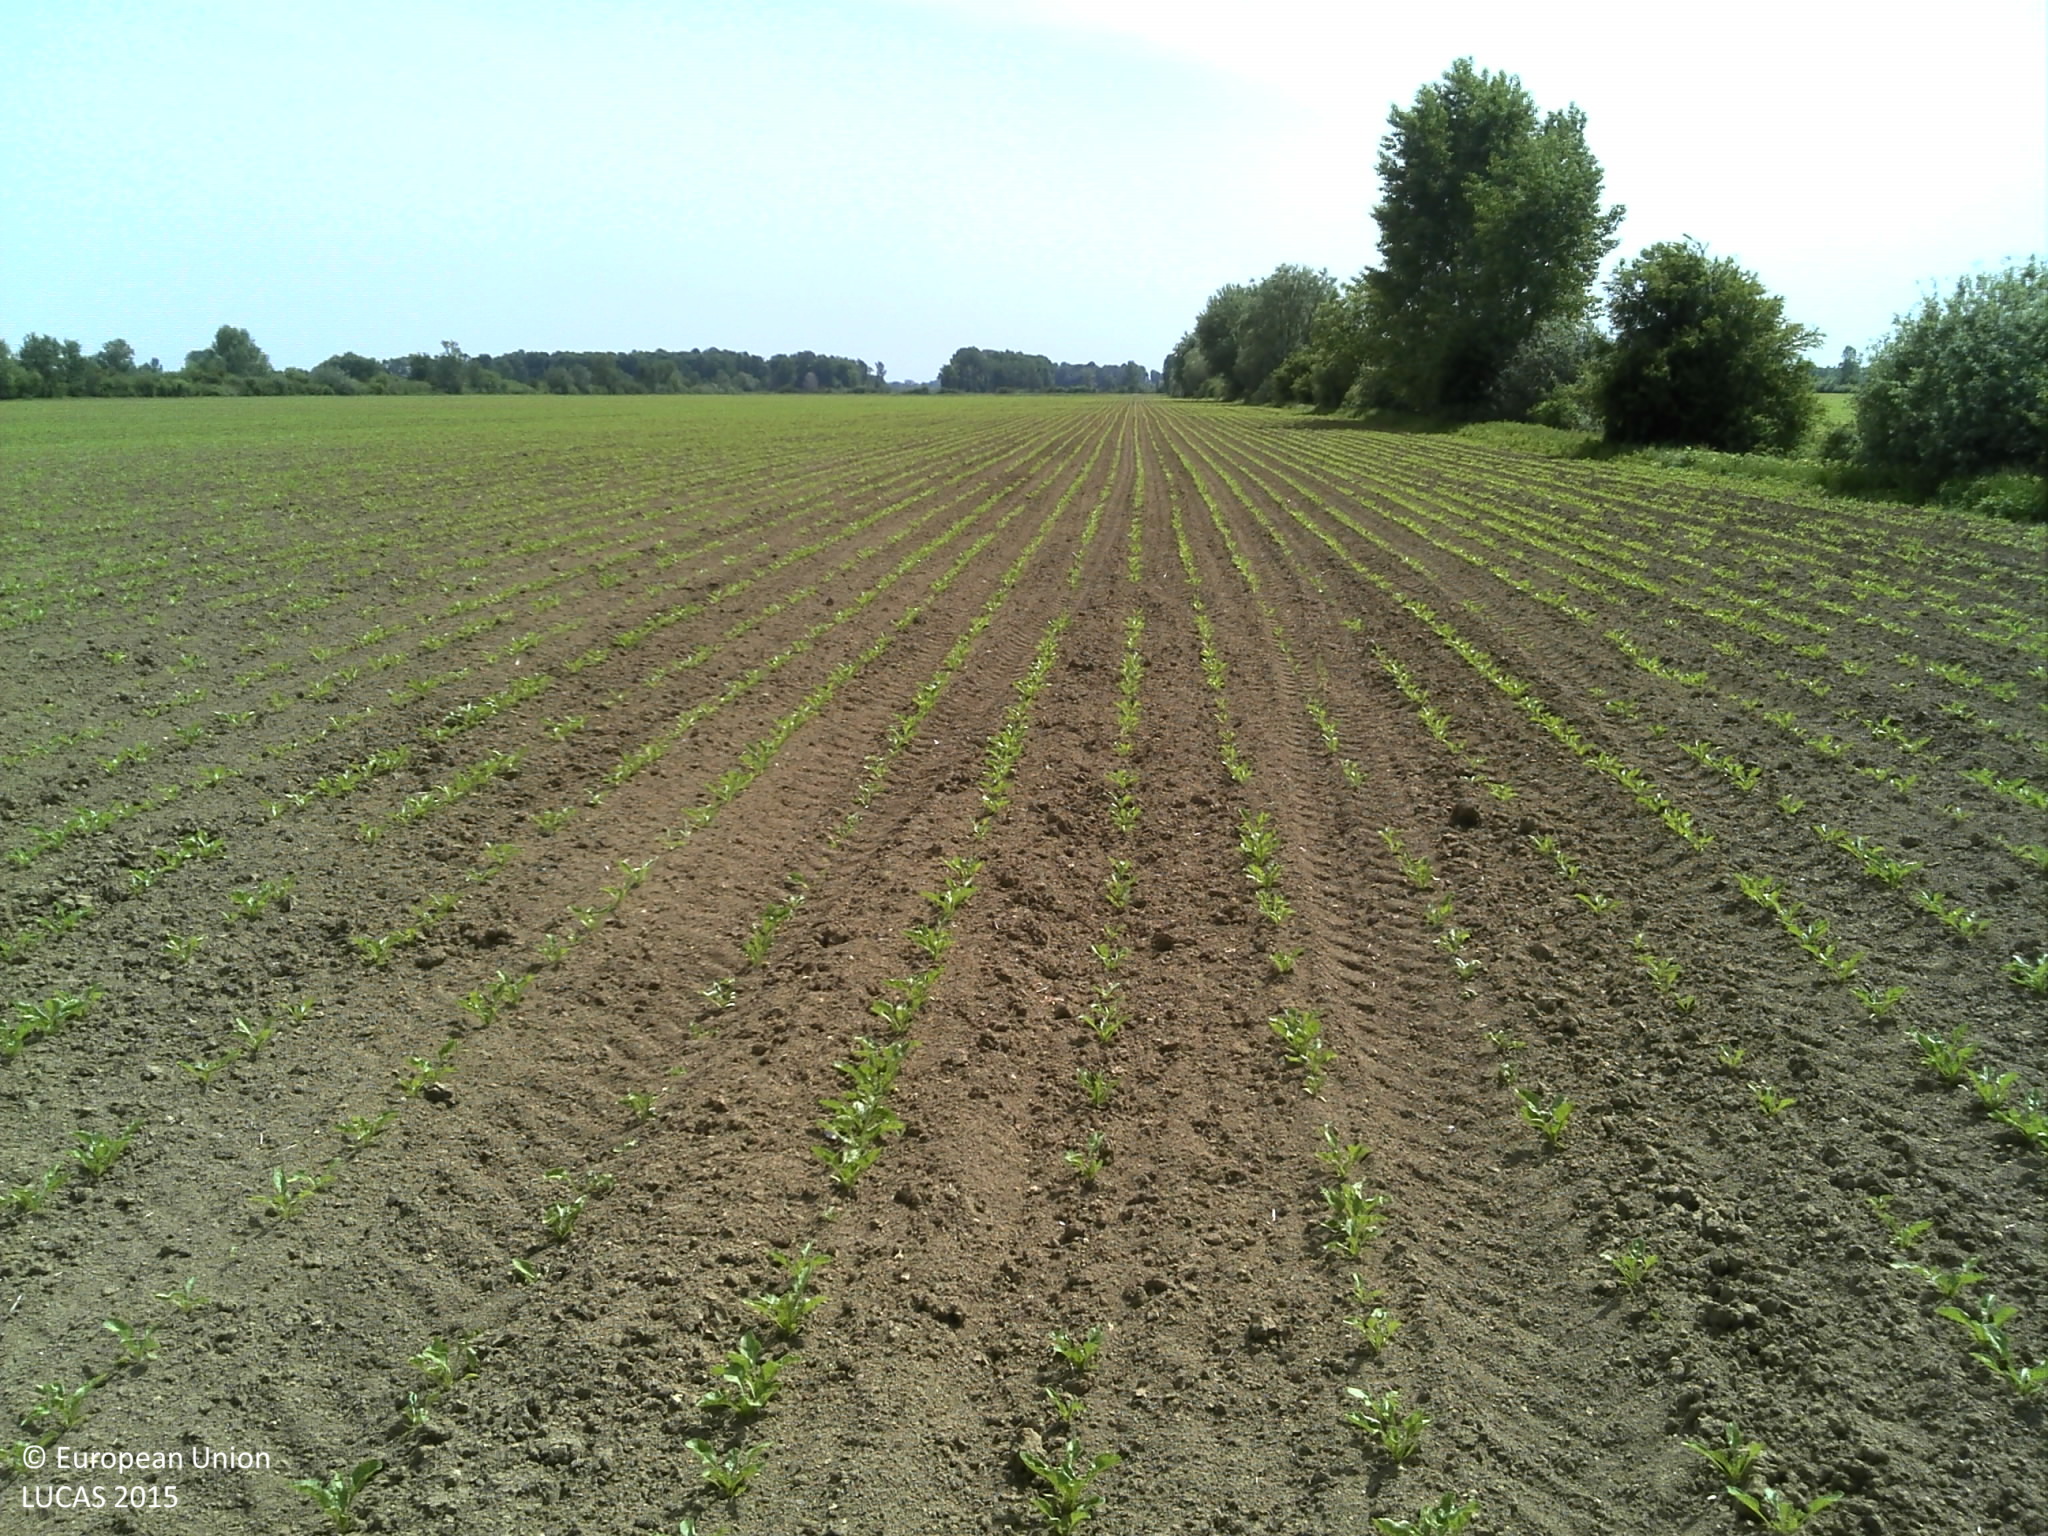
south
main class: Cropland
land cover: Sugar beet
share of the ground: < 10 %
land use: Agriculture (excluding fallow land and kitchen gardens)
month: May
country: HR
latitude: 45.1977
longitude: 18.4958
